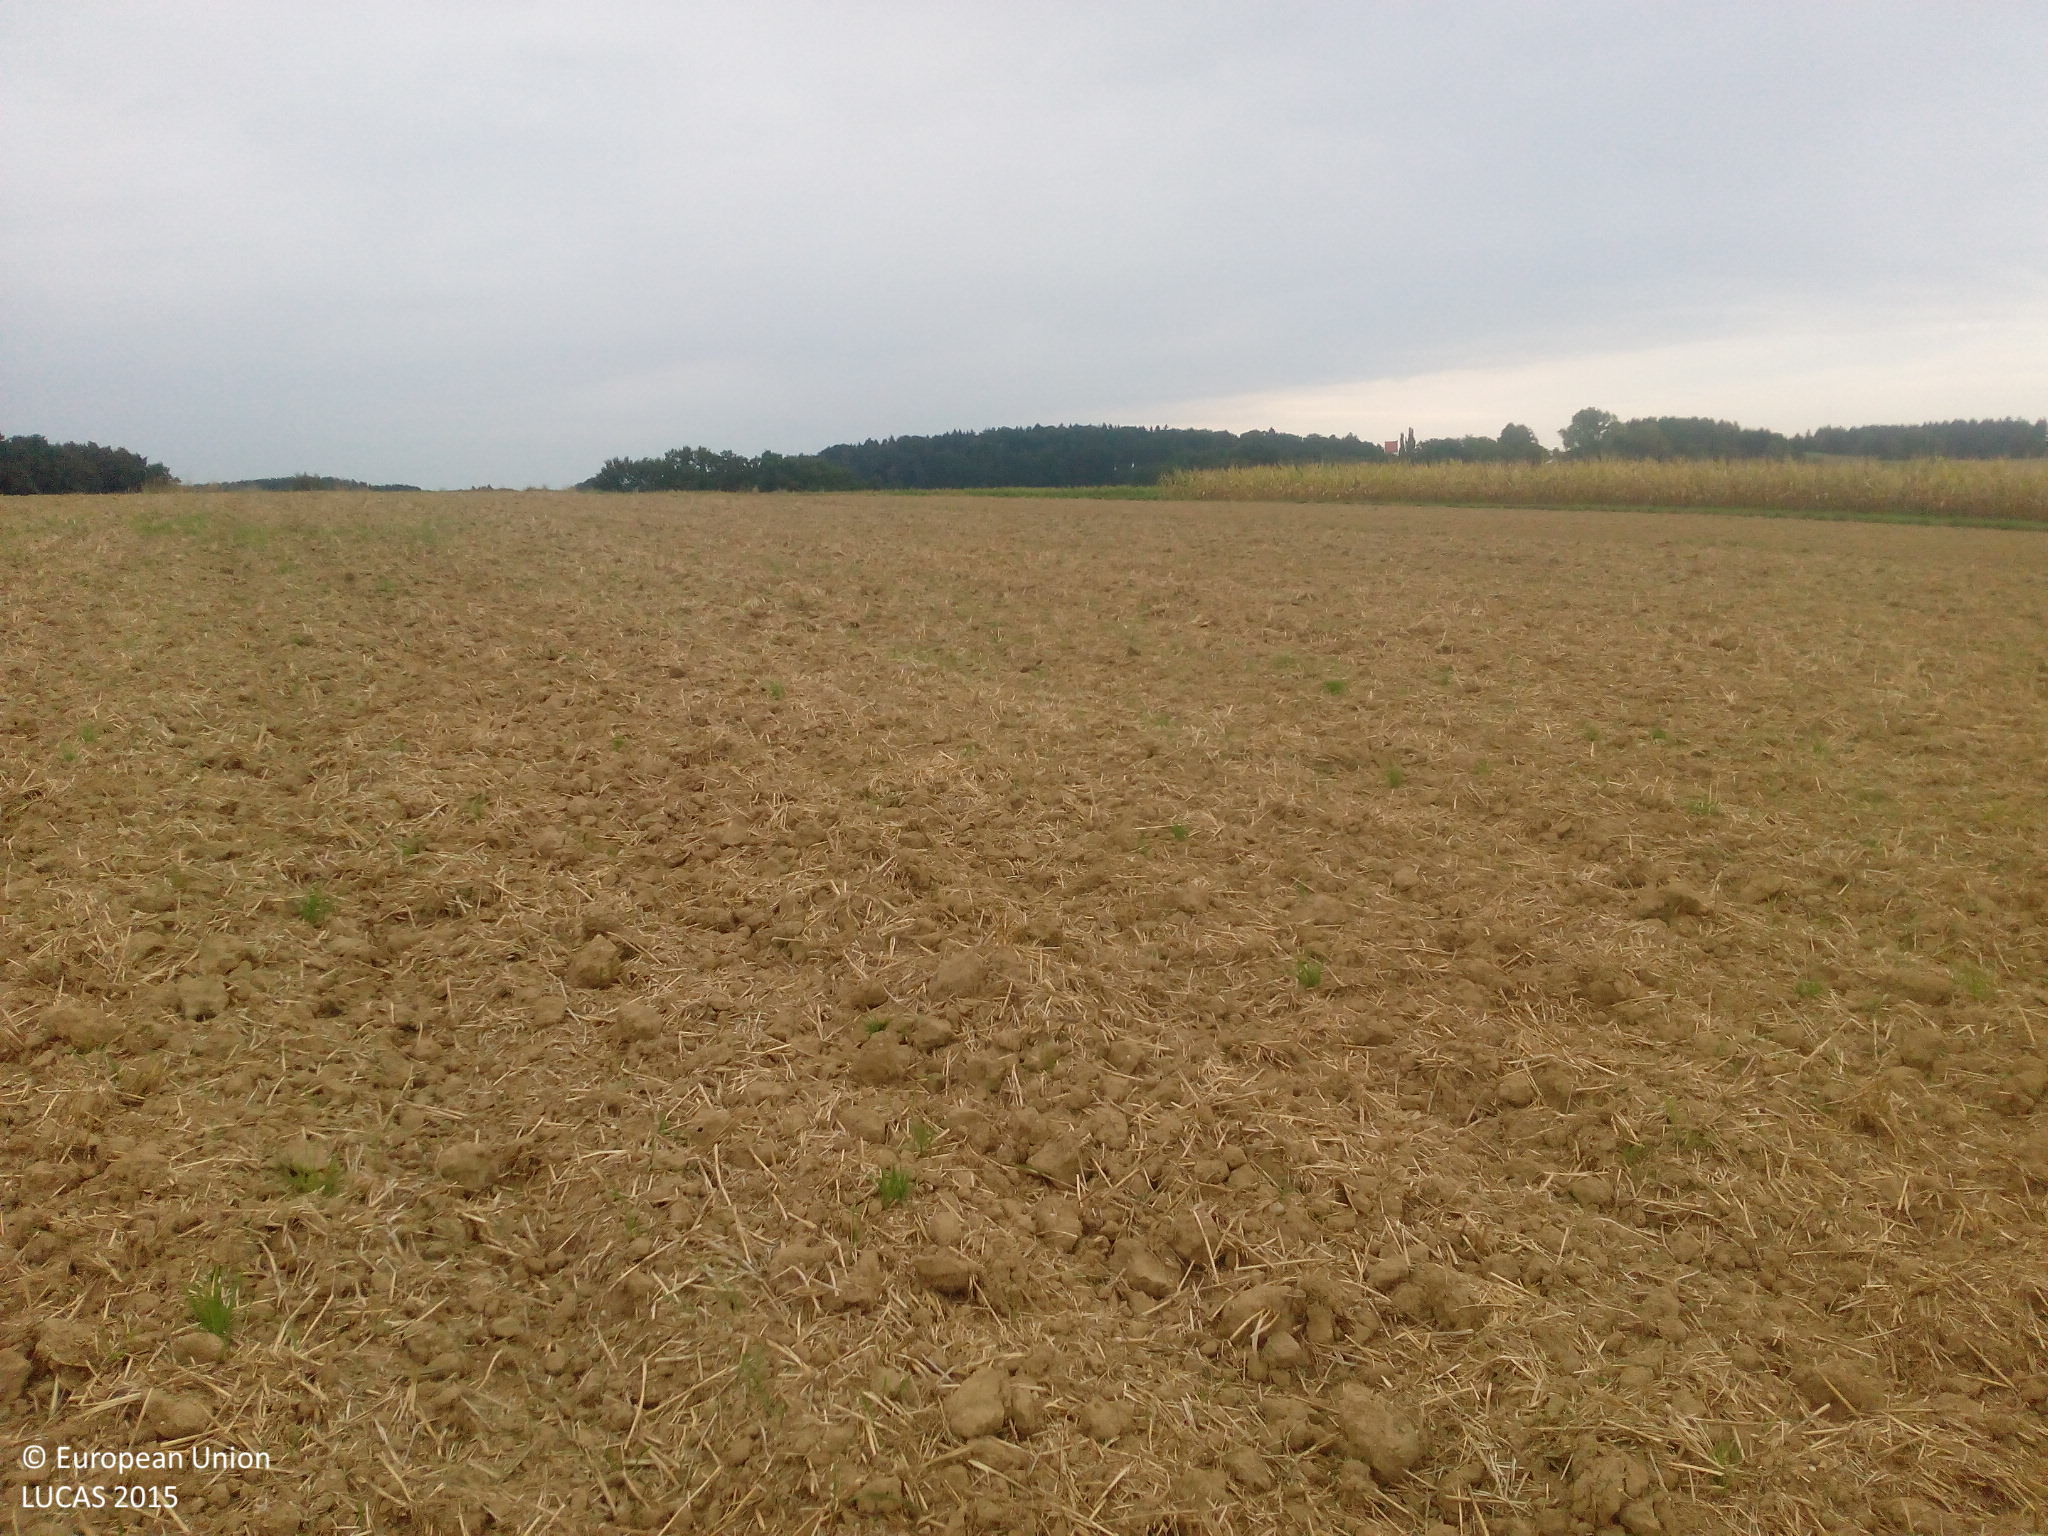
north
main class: Cropland
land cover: Common wheat
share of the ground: < 10 %
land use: Agriculture (excluding fallow land and kitchen gardens)
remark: Harvested field
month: September
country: DE
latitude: 48.4477
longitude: 11.4729
